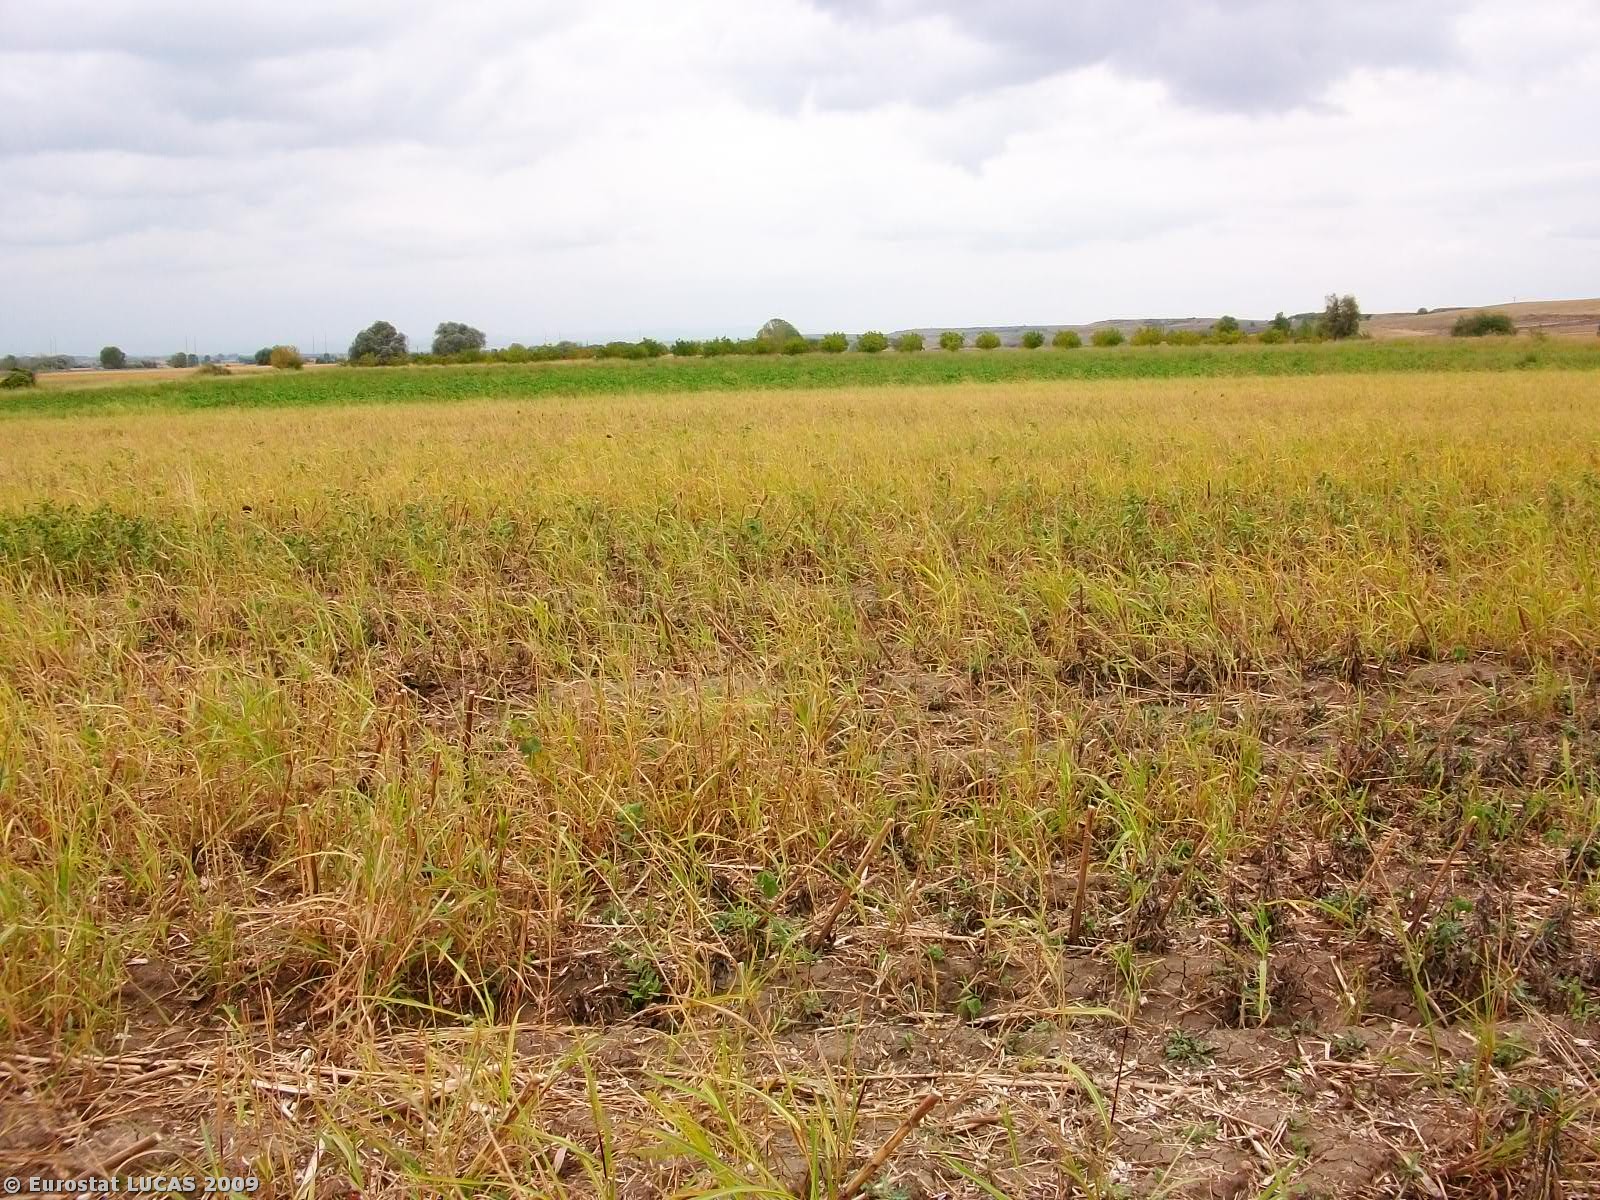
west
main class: Cropland
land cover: Sunflower
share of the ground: < 10 %
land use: Agriculture (excluding fallow land and kitchen gardens)
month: September
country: GR
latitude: 41.6661
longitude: 26.4499
